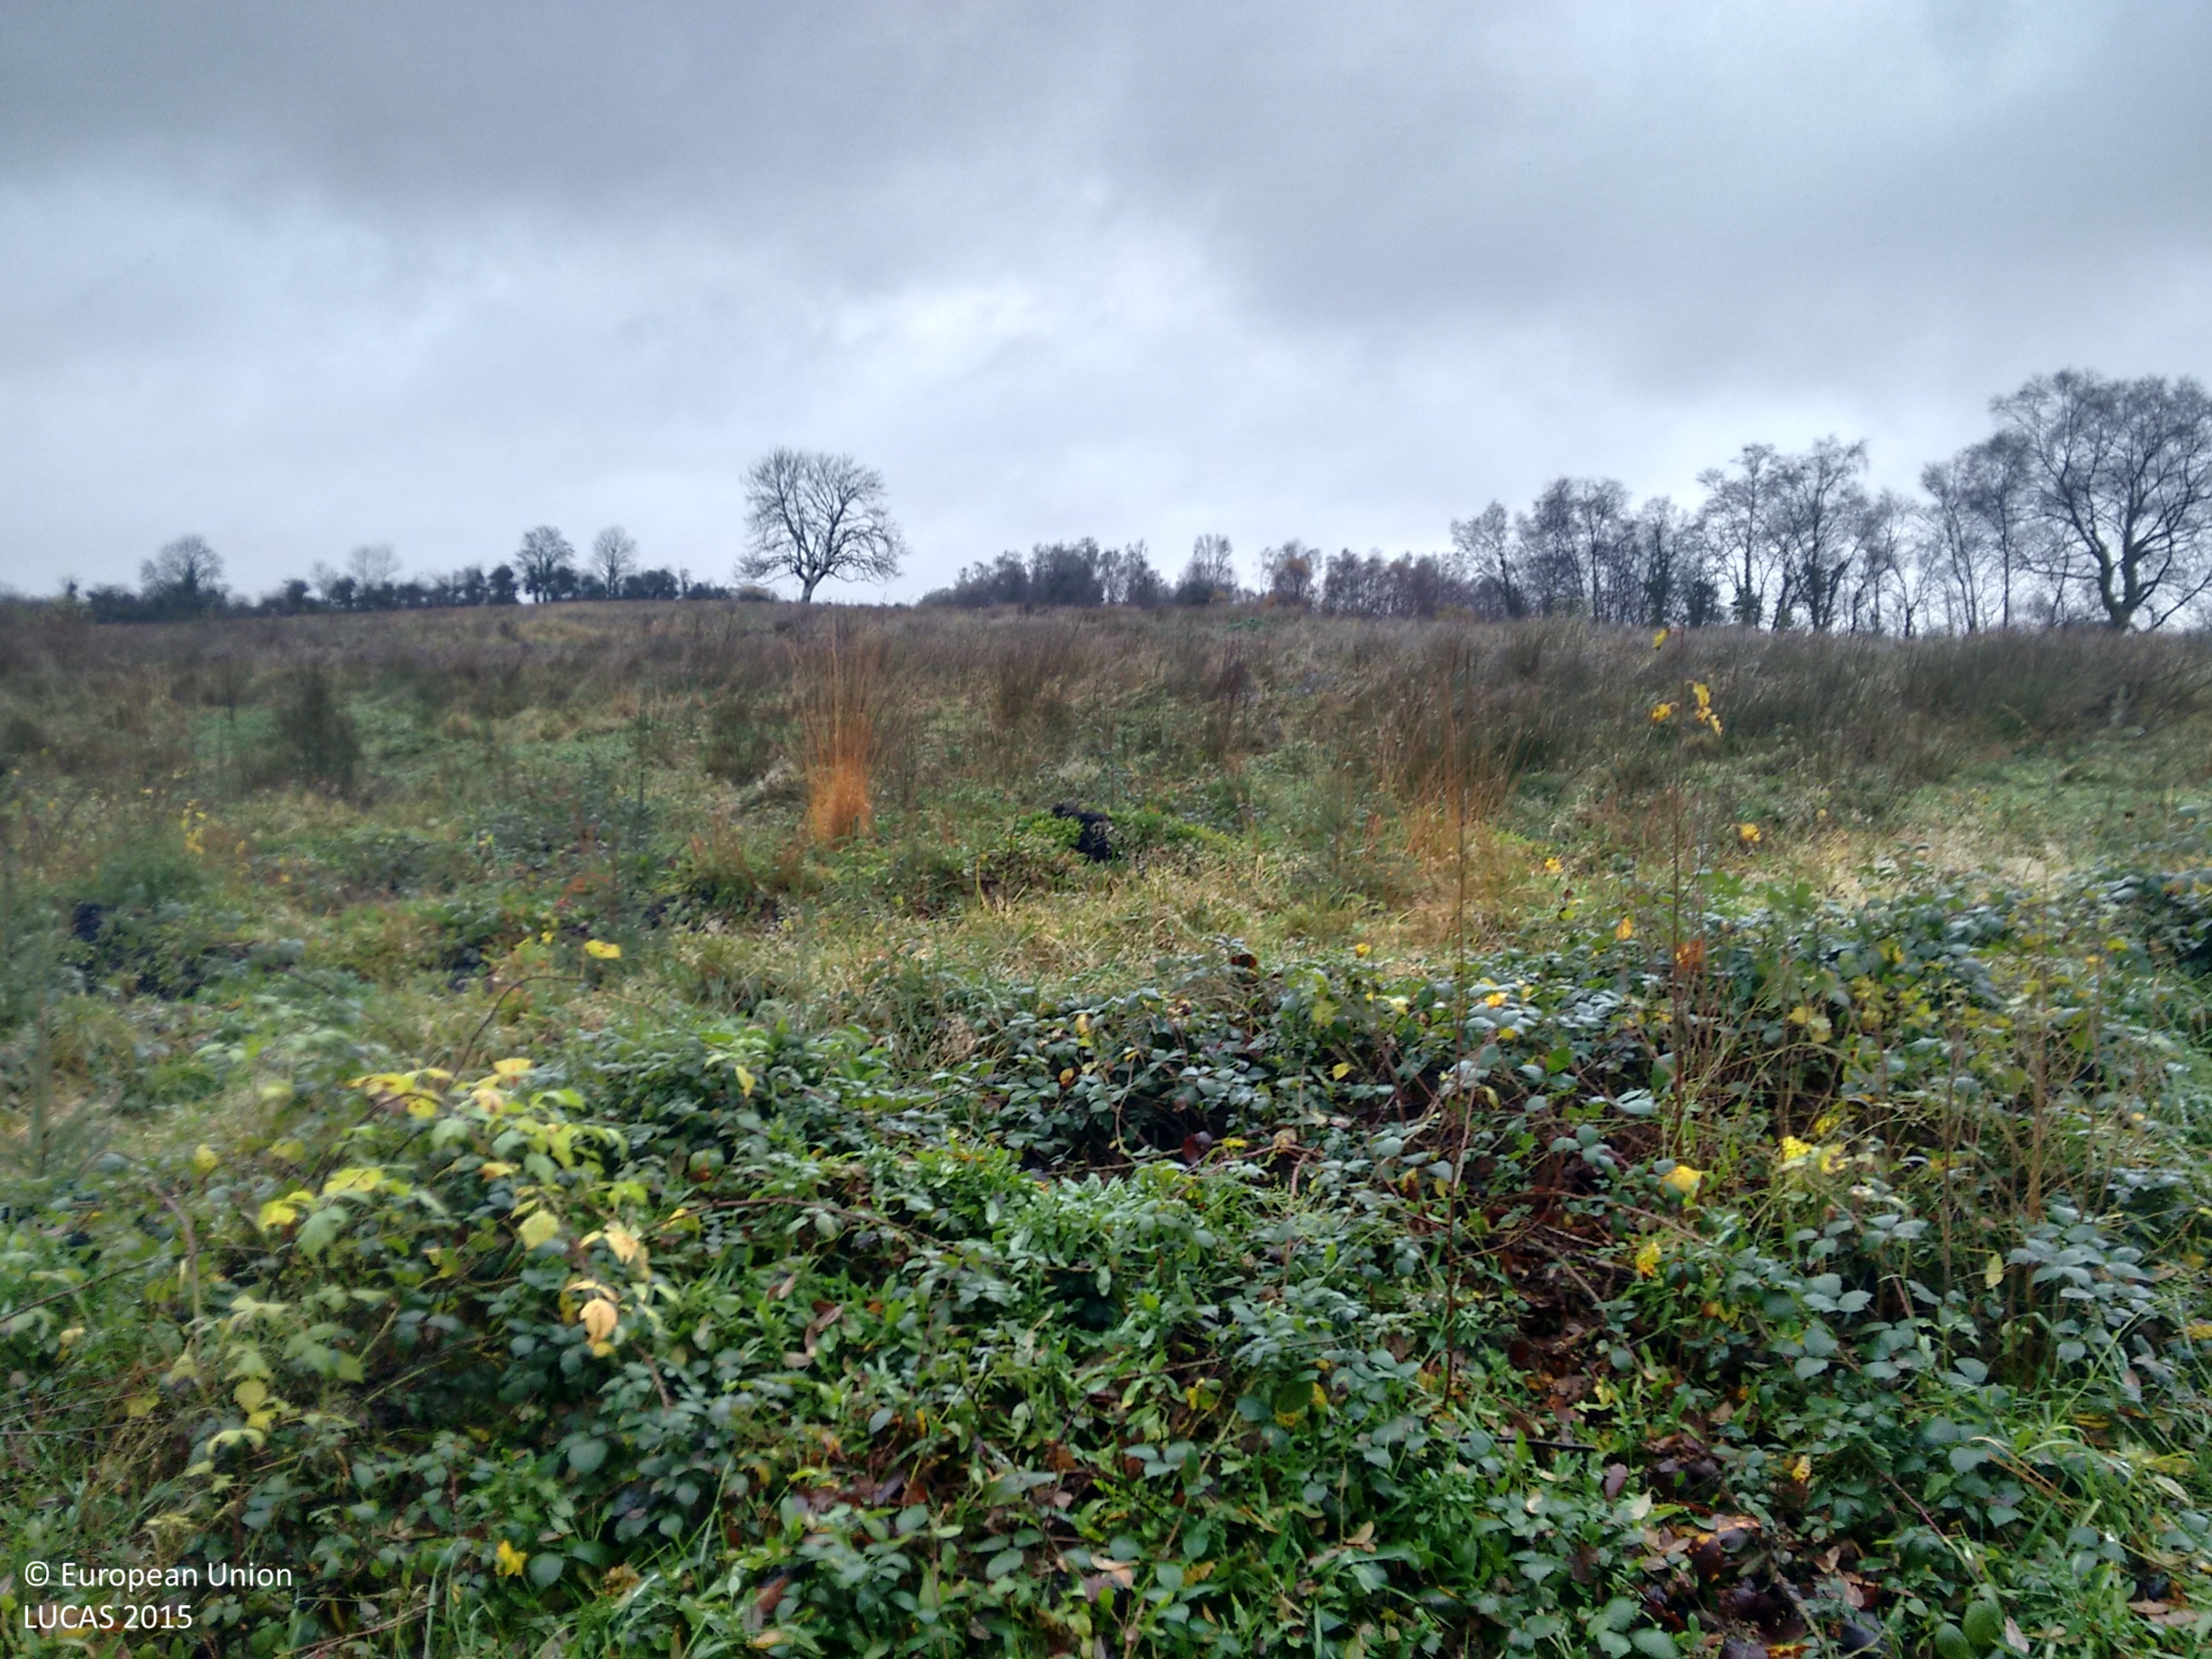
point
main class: Grassland
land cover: Spontaneously vegetated surfaces
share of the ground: > 75 %
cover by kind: herbaceous plants 95 %, shrubs 5 %
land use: Agriculture (excluding fallow land and kitchen gardens)
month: November
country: IE
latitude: 53.9361
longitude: -7.8855
